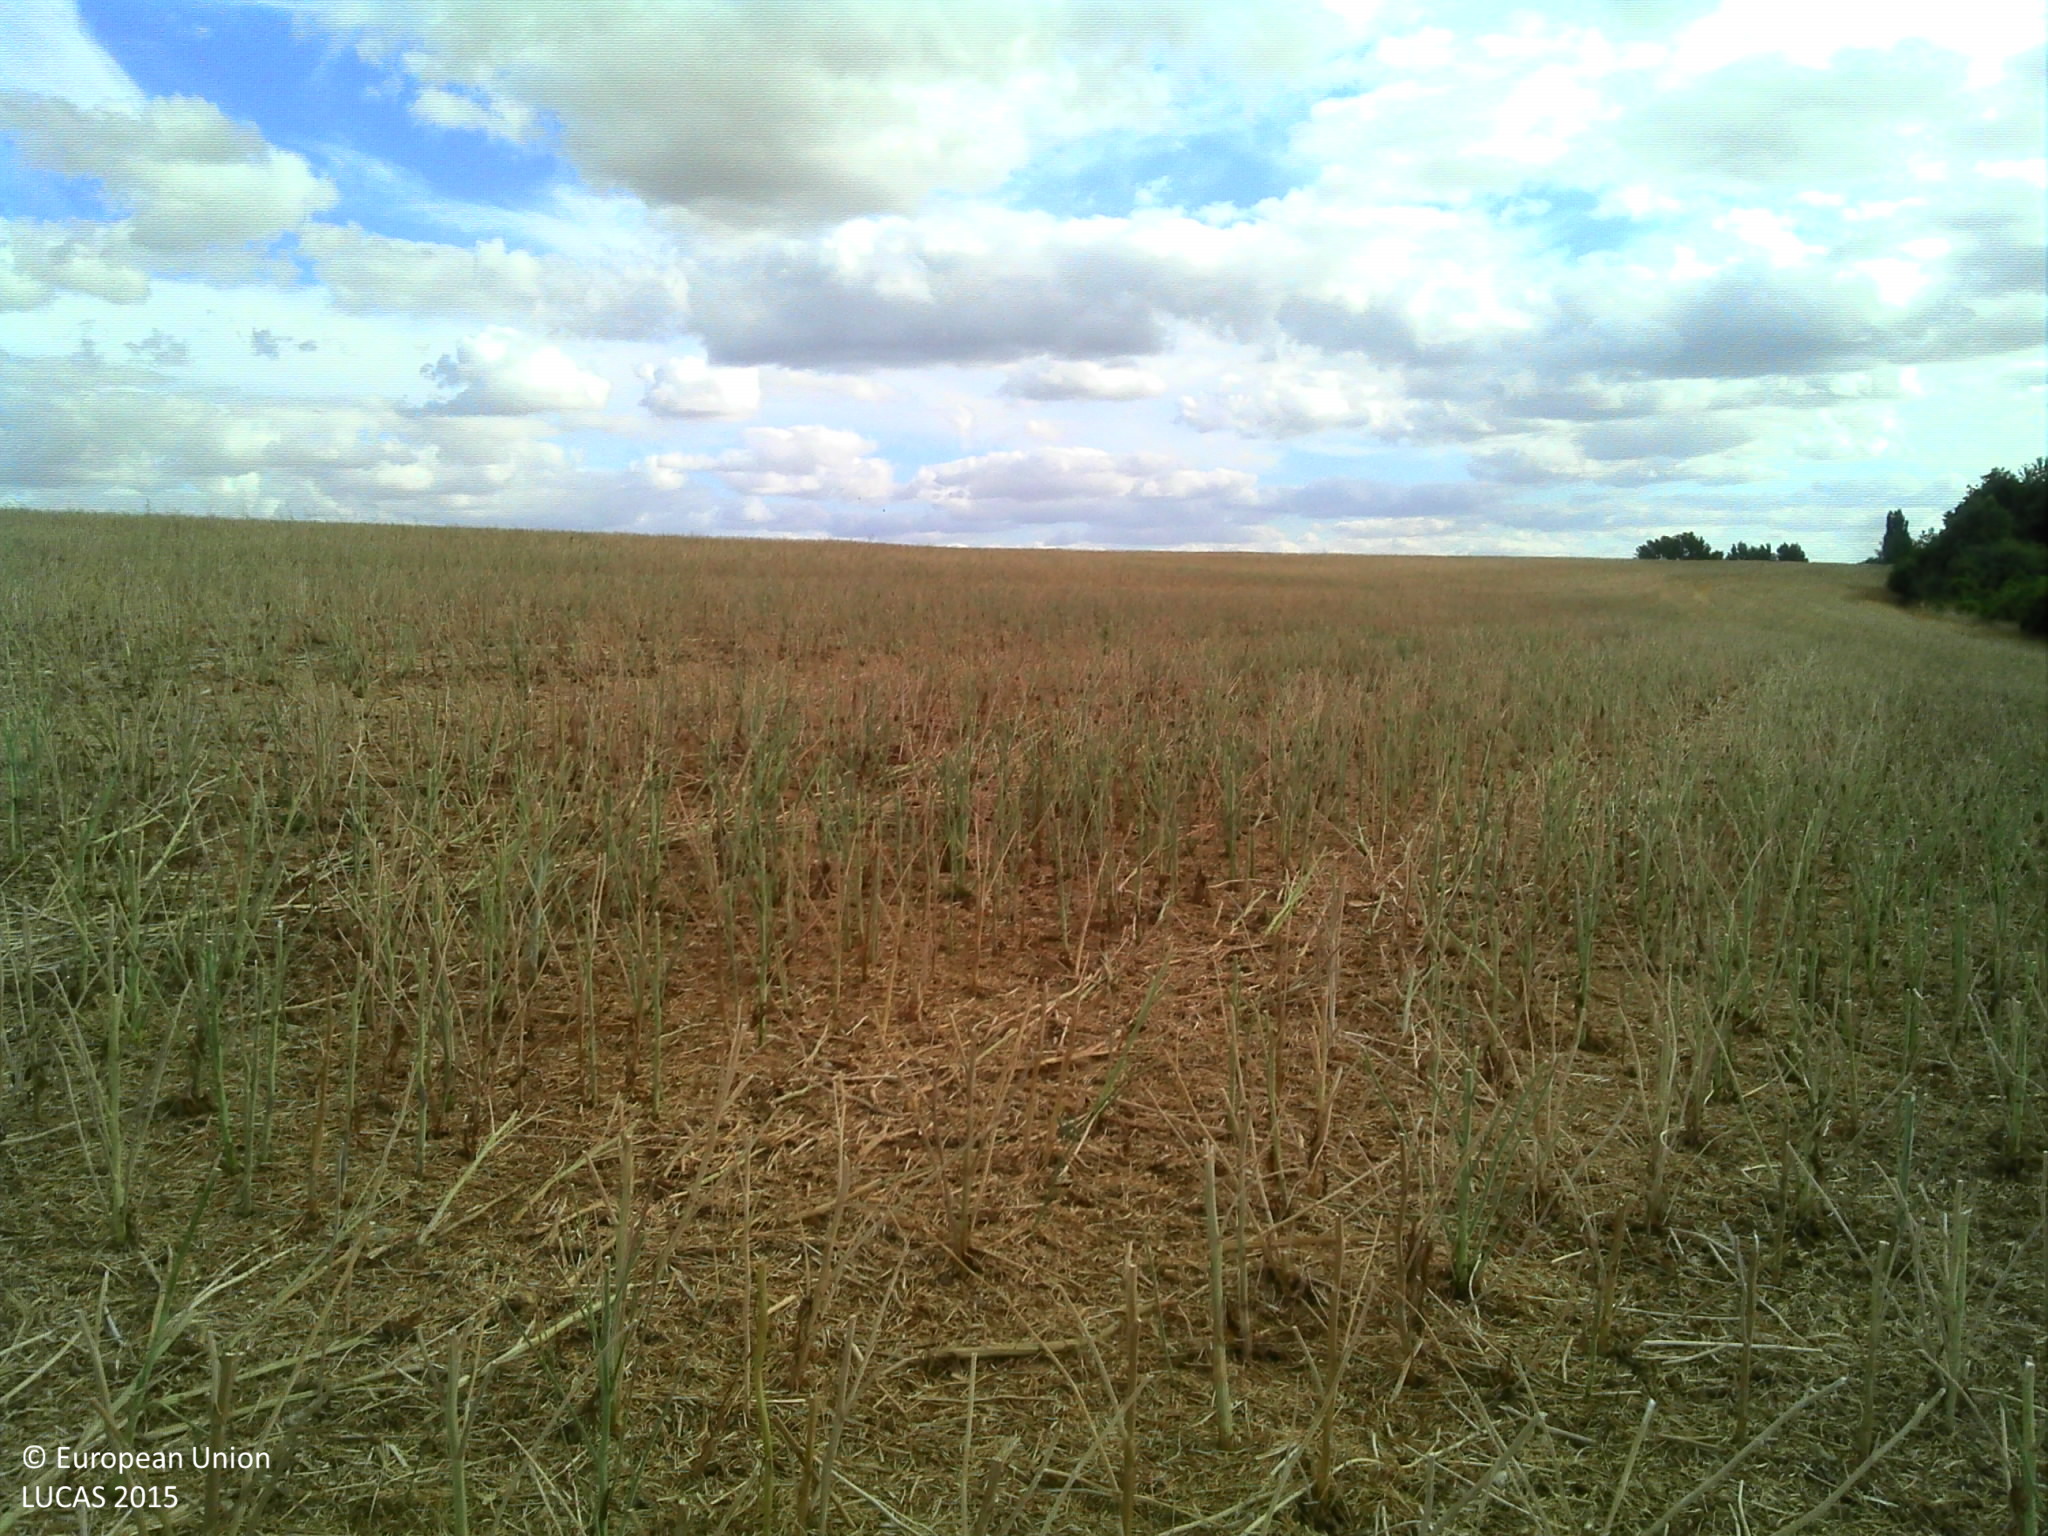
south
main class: Cropland
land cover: Rape and turnip rape
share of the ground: > 75 %
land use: Agriculture (excluding fallow land and kitchen gardens)
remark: Harvested field
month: July
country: FR
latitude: 47.9888
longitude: 1.3136
